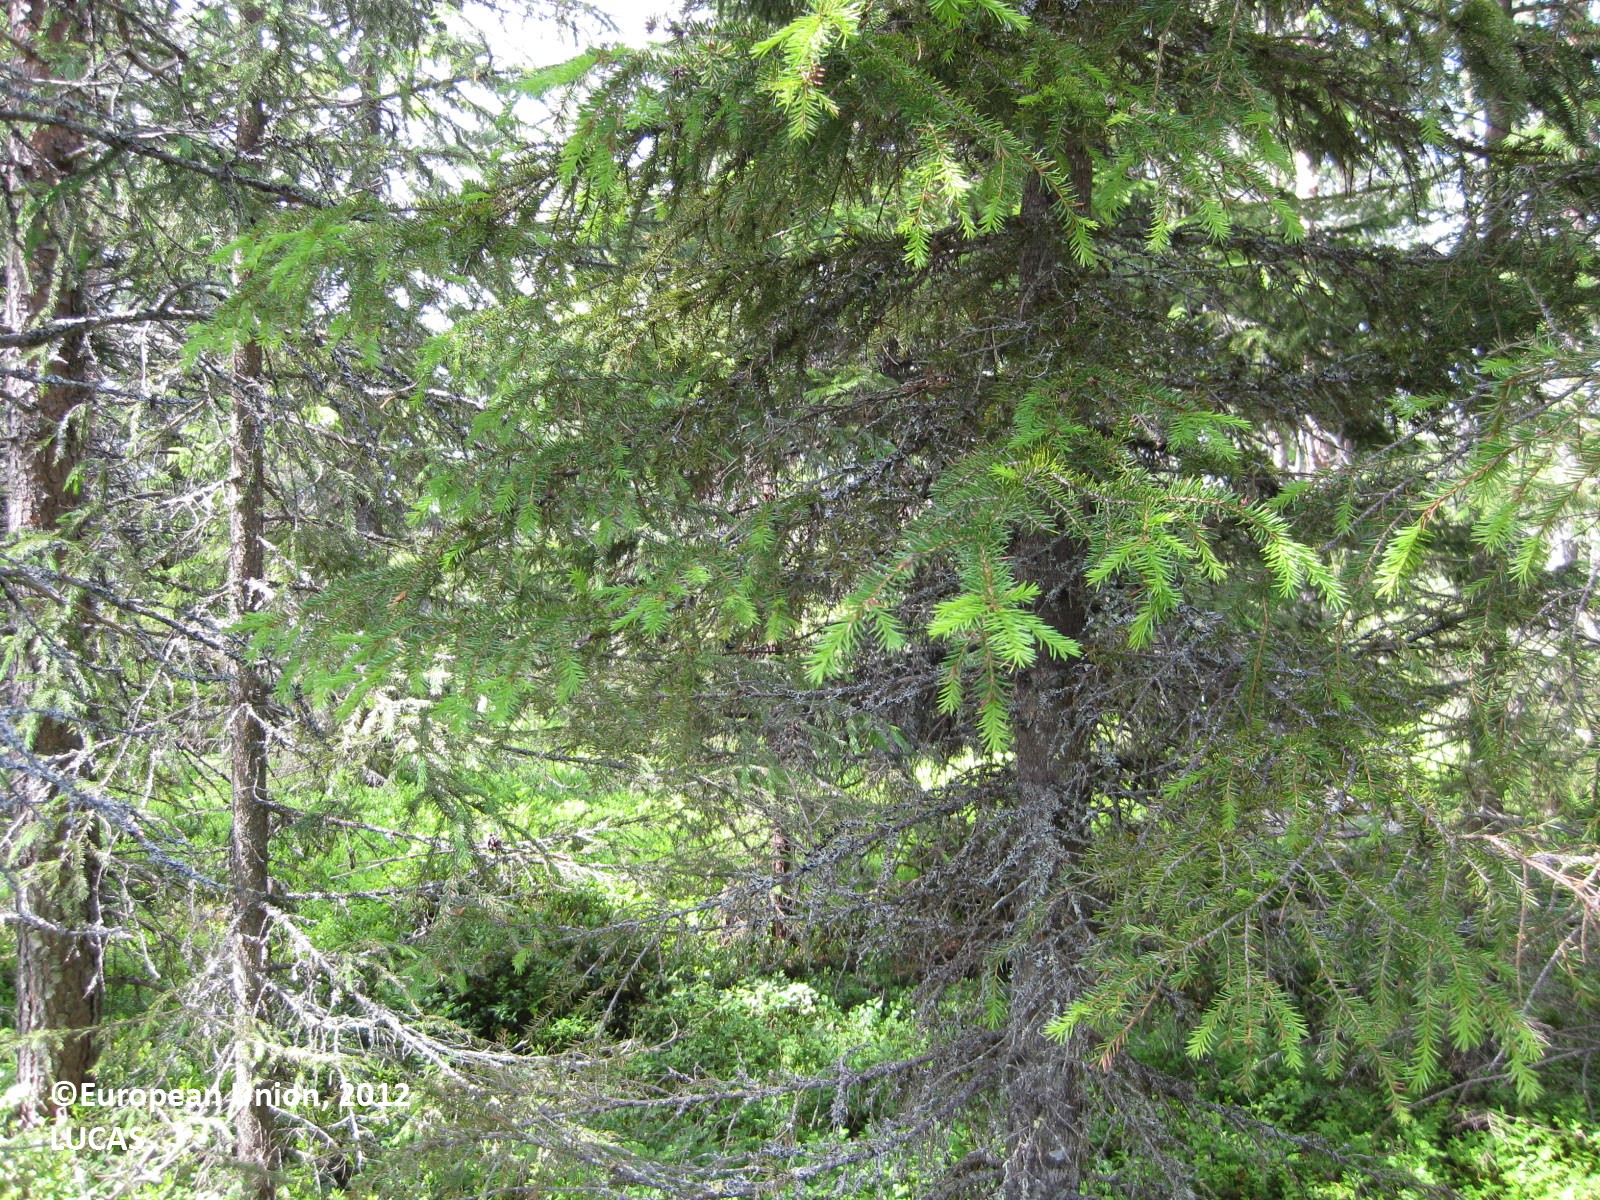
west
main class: Woodland
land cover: Other coniferous woodland
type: boreal forest
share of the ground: 50 - 75 %
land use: Forestry
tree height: > 5 m
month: July
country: FI
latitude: 65.5495
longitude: 29.3541
